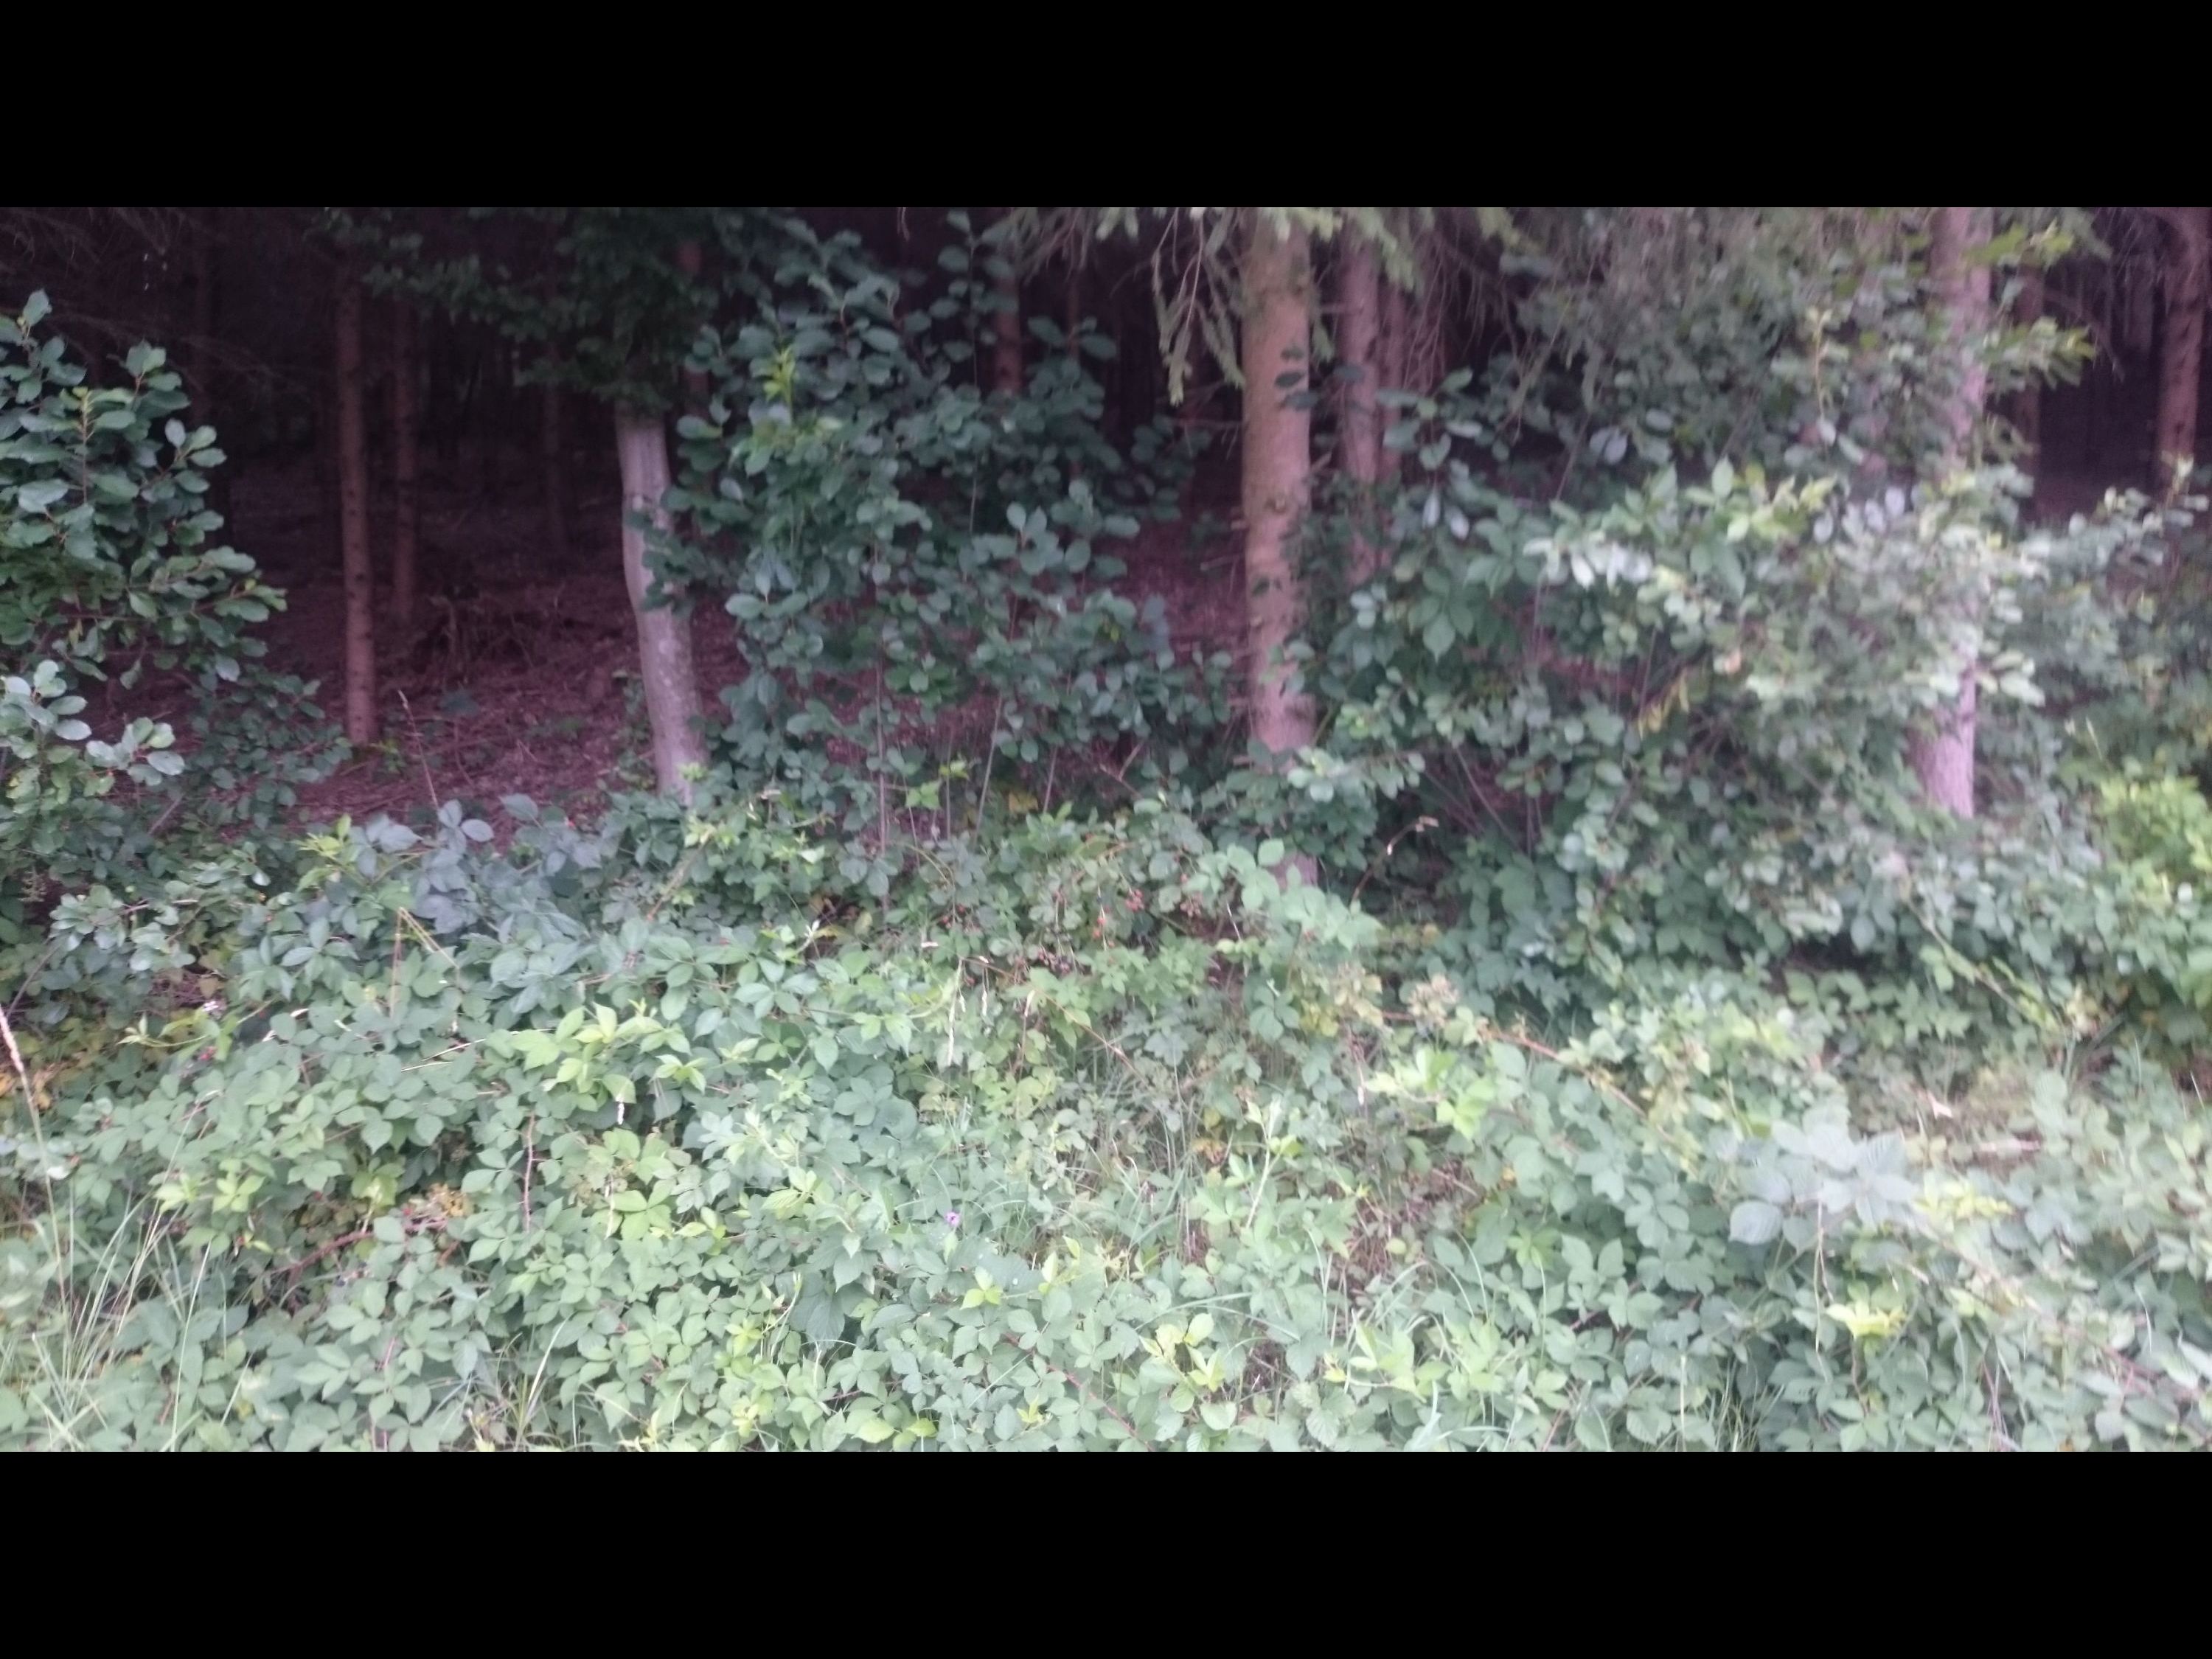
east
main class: Grassland
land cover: Grassland without tree/shrub cover
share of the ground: > 75 %
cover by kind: herbaceous plants 100 %
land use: Agriculture (excluding fallow land and kitchen gardens)
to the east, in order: Grassland without tree/shrub cover; Fences; Grassland without tree/shrub cover; Spruce dominated coniferous woodland; Tracks; Spruce dominated coniferous woodland; Tracks; Spruce dominated mixed woodland; Paved roads, cycling and walking lanes; Ditches and canals; Spruce dominated mixed woodland; Pine dominated mixed woodland
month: July
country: AT
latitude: 46.9617
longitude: 15.9540
